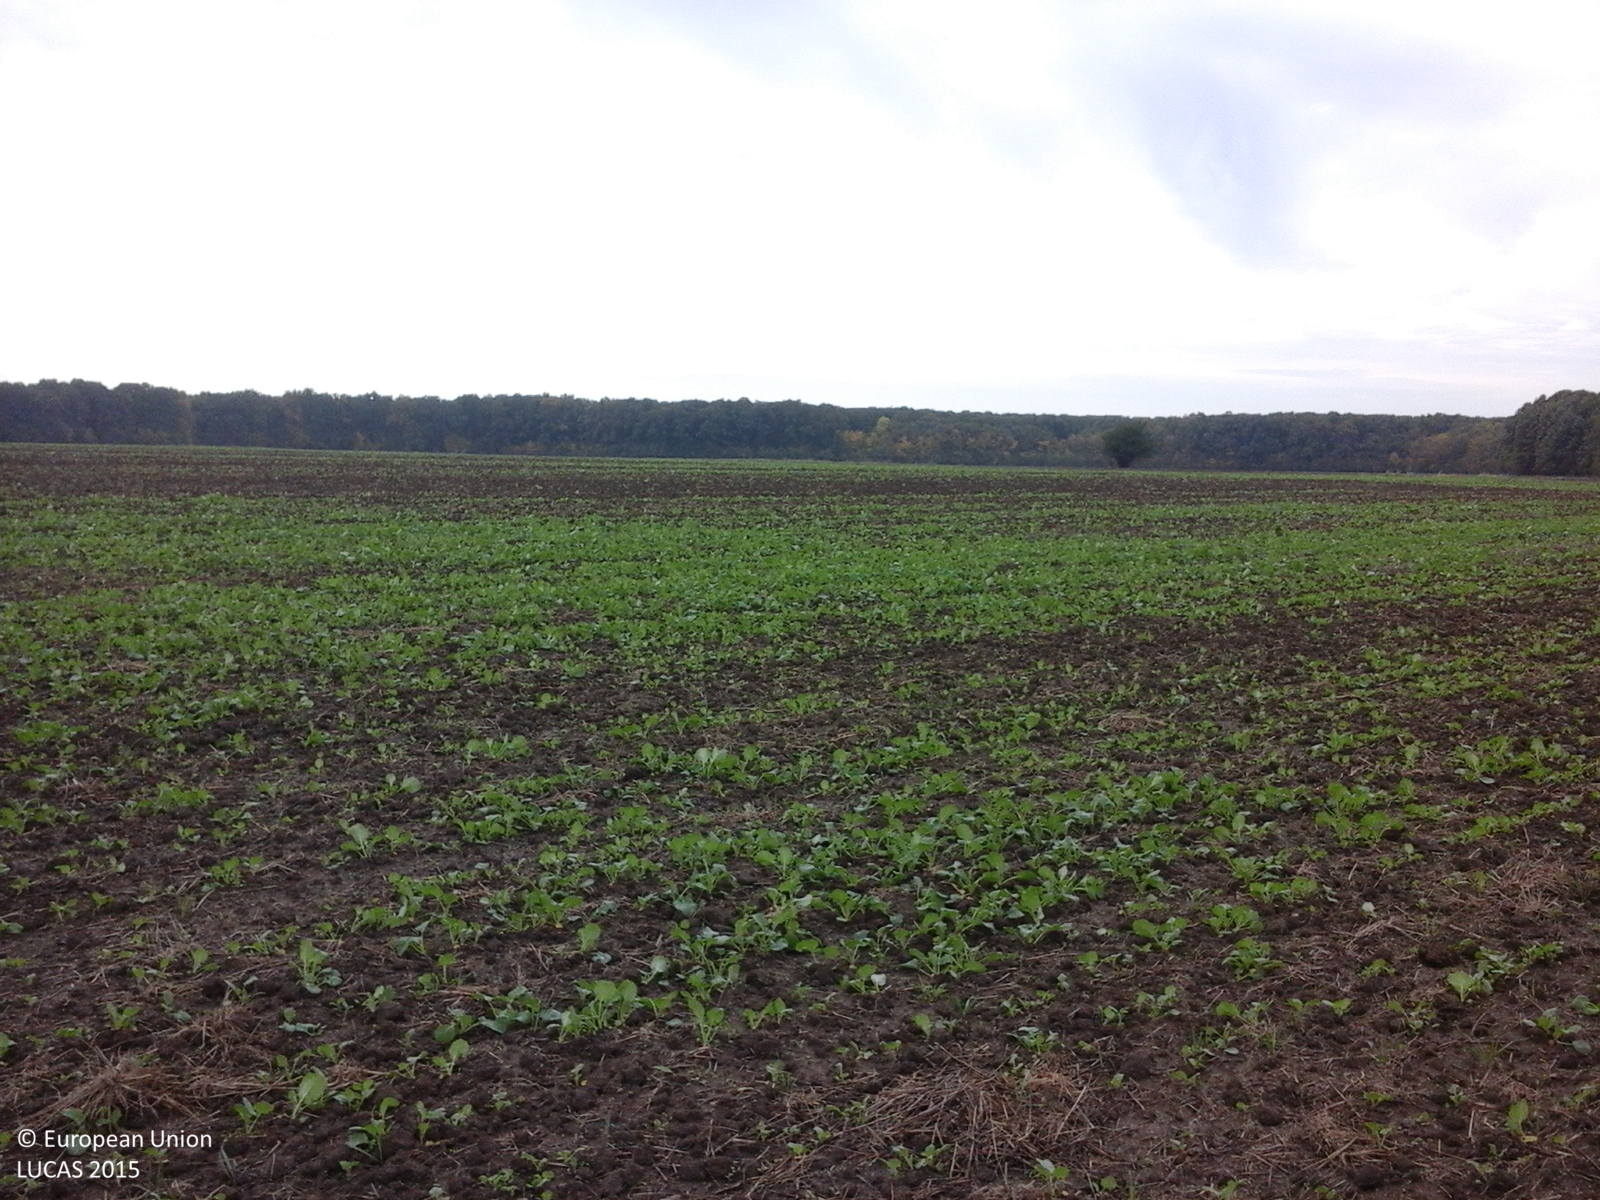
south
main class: Cropland
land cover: Rape and turnip rape
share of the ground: 25 - 50 %
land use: Agriculture (excluding fallow land and kitchen gardens)
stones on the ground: < 10 %
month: October
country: RO
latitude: 44.7017
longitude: 26.2014
